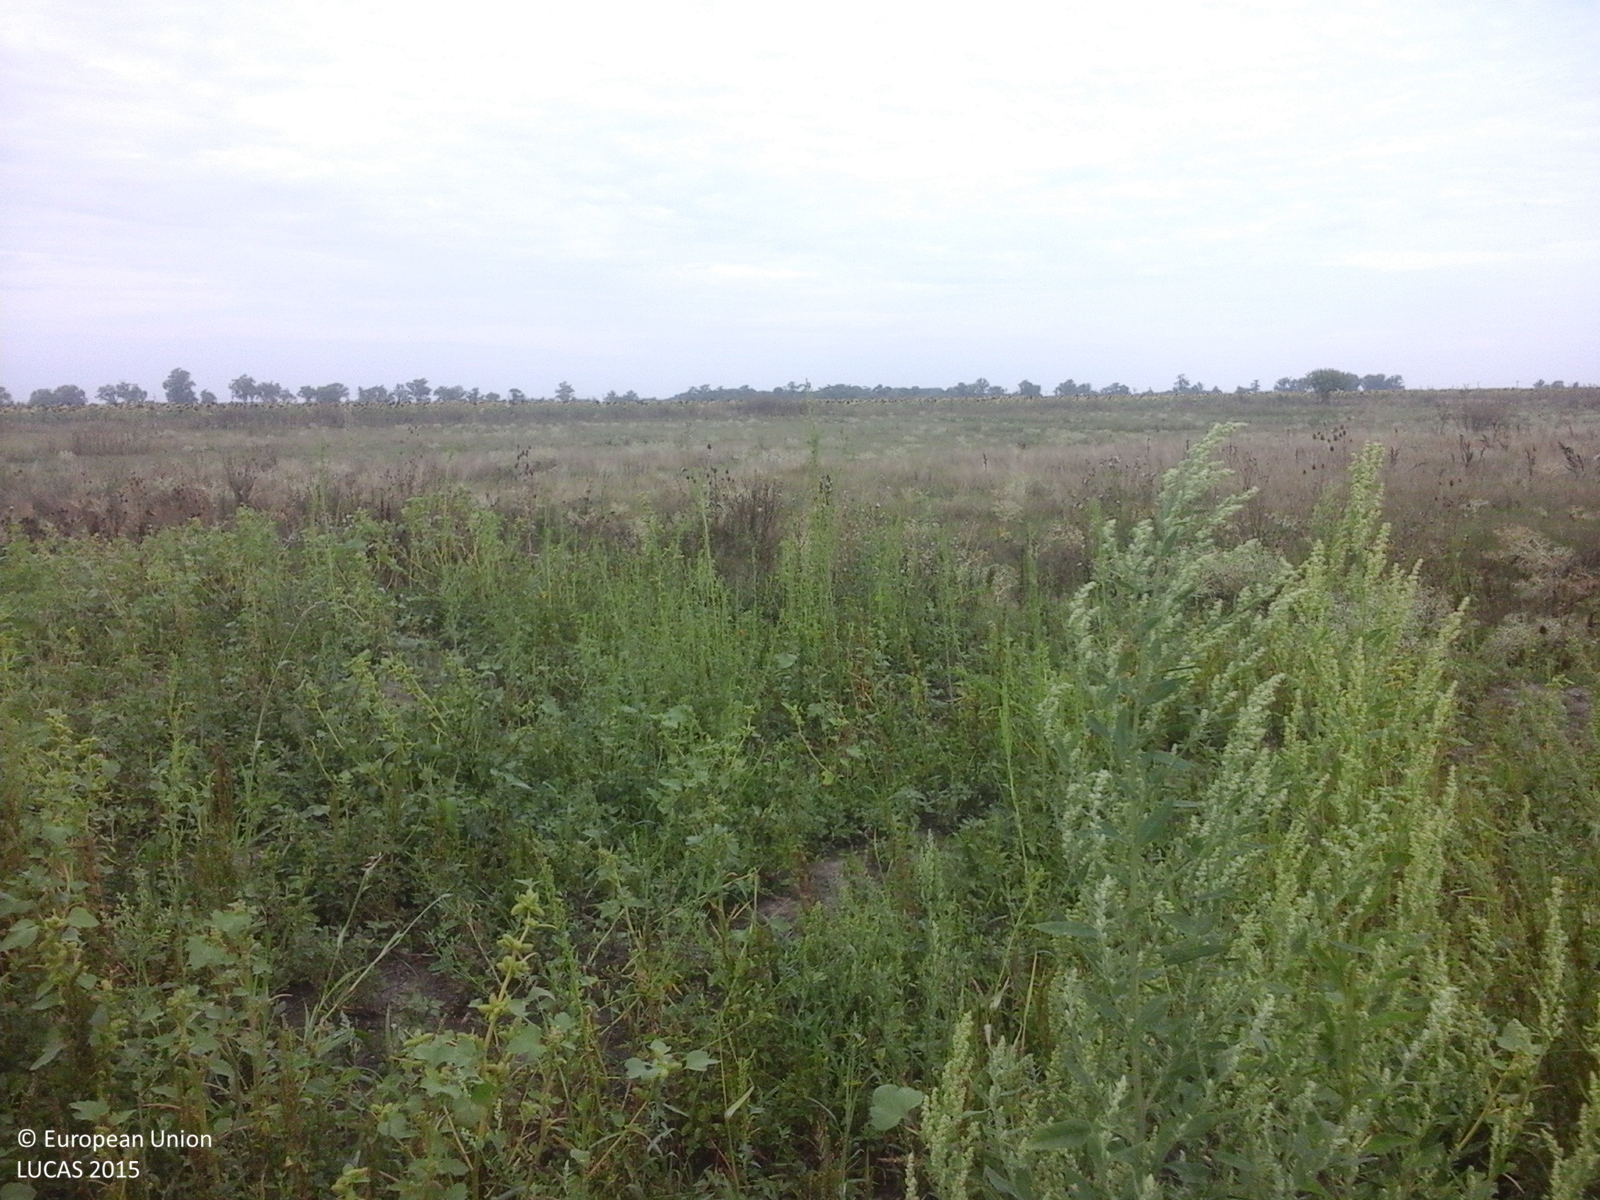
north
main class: Cropland
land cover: Maize
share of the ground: > 75 %
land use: Agriculture (excluding fallow land and kitchen gardens)
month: August
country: RO
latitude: 46.3364
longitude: 21.4295
